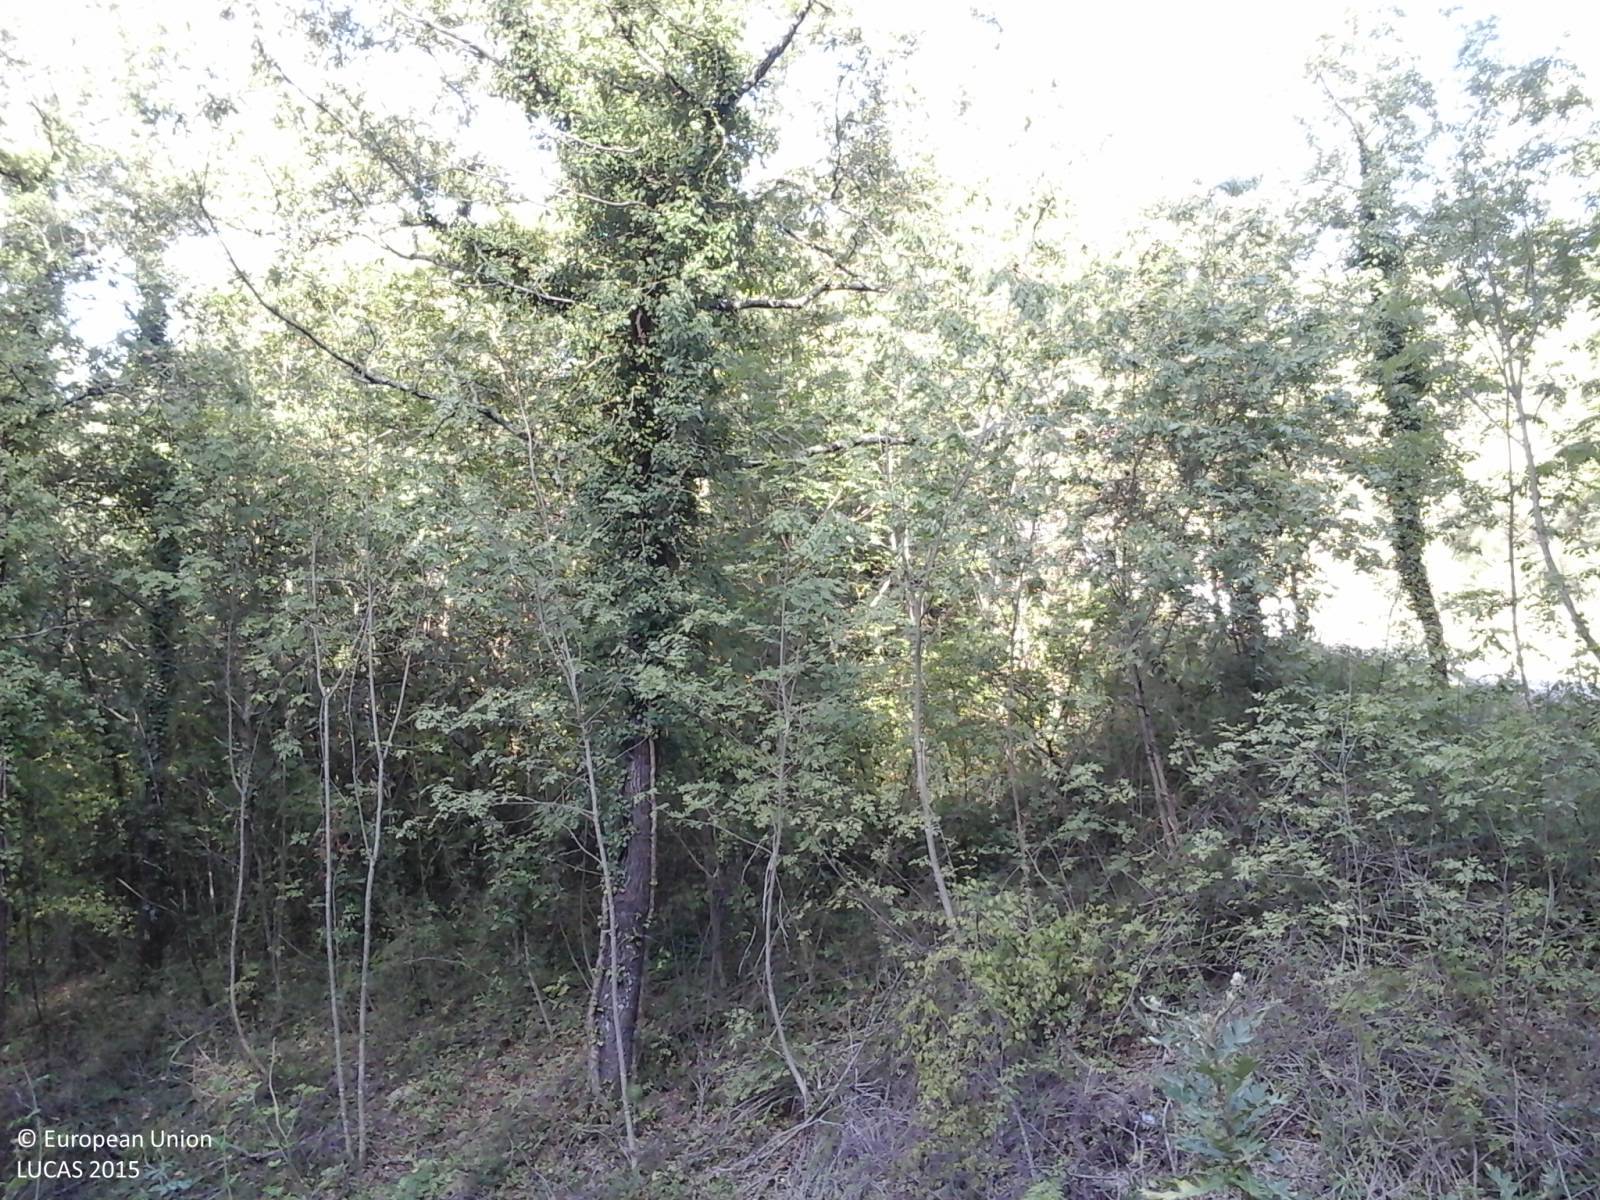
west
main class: Woodland
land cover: Broadleaved woodland
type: mesophytic deciduous forest
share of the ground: > 75 %
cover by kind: broadleaved forest trees 85 %, shrubs 15 %
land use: Forestry
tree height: > 5 m
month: September
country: IT
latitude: 43.1502
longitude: 12.3665
